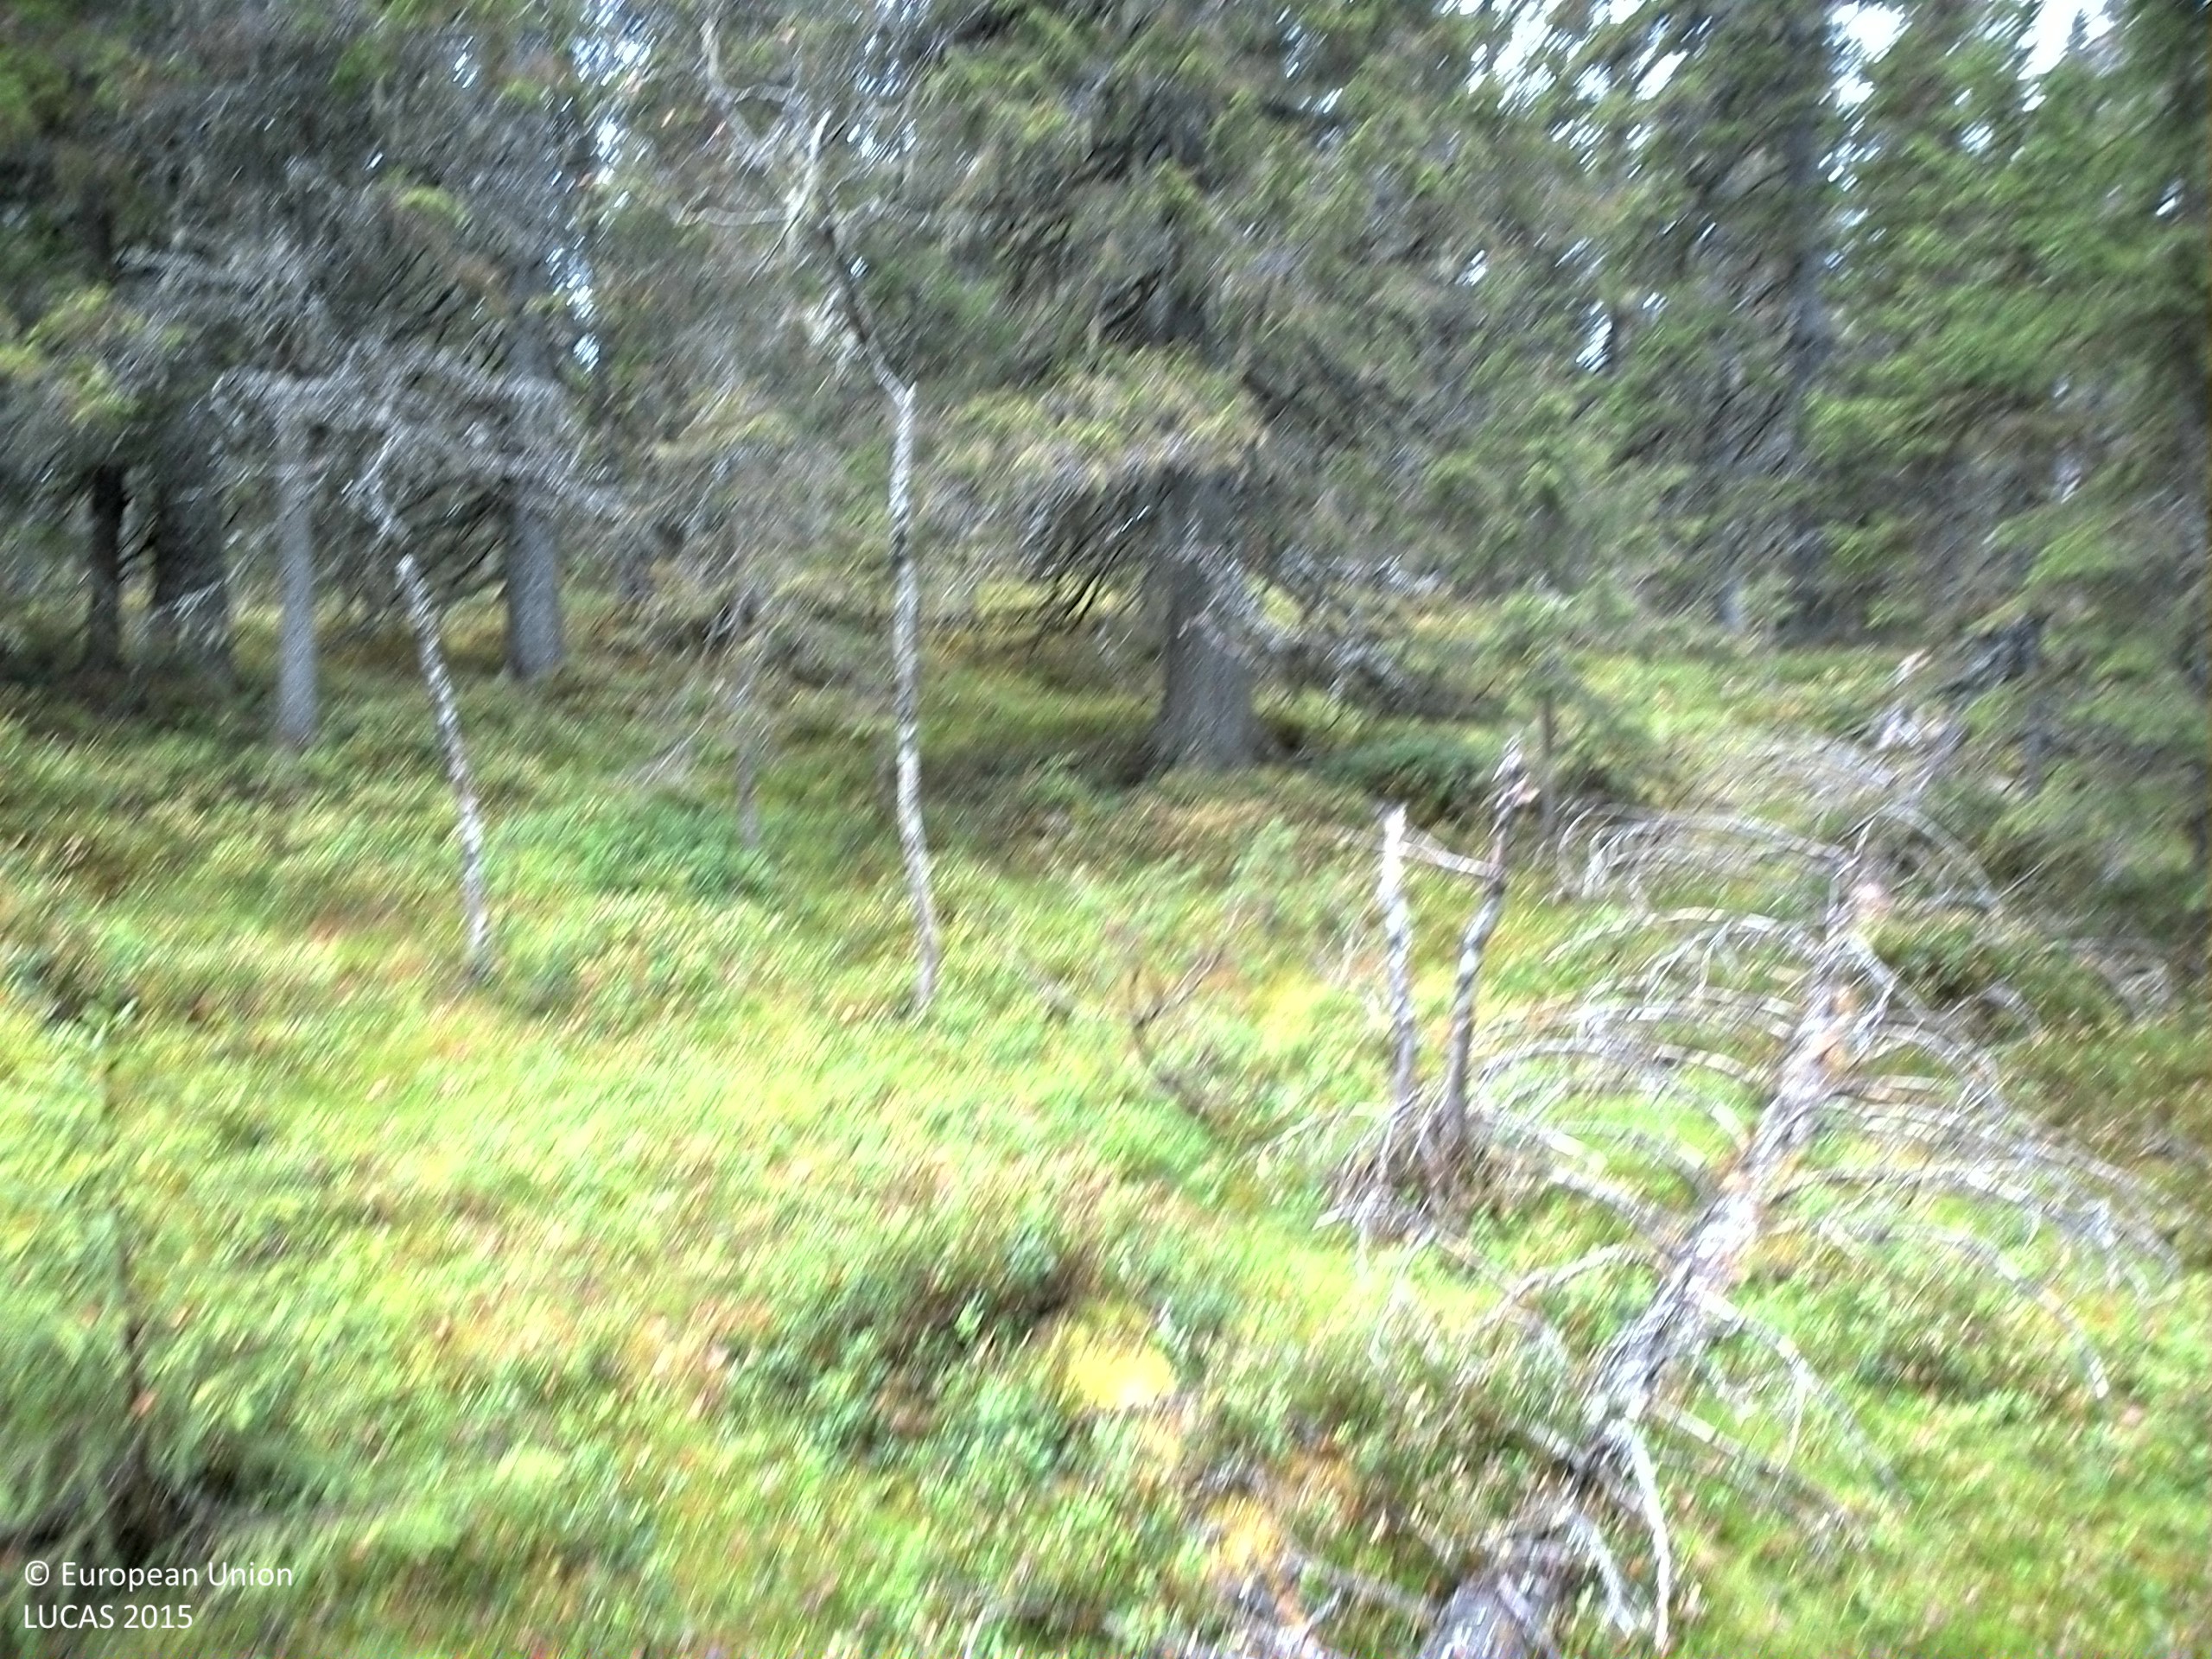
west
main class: Woodland
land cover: Spruce dominated coniferous woodland
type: boreal forest
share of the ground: 25 - 50 %
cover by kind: coniferous forest trees 45 %, shrubs 35 %, lichens and mosses 20 %
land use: Amenities, museums, leisure
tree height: > 5 m
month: October
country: SE
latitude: 61.3584
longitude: 14.3433
